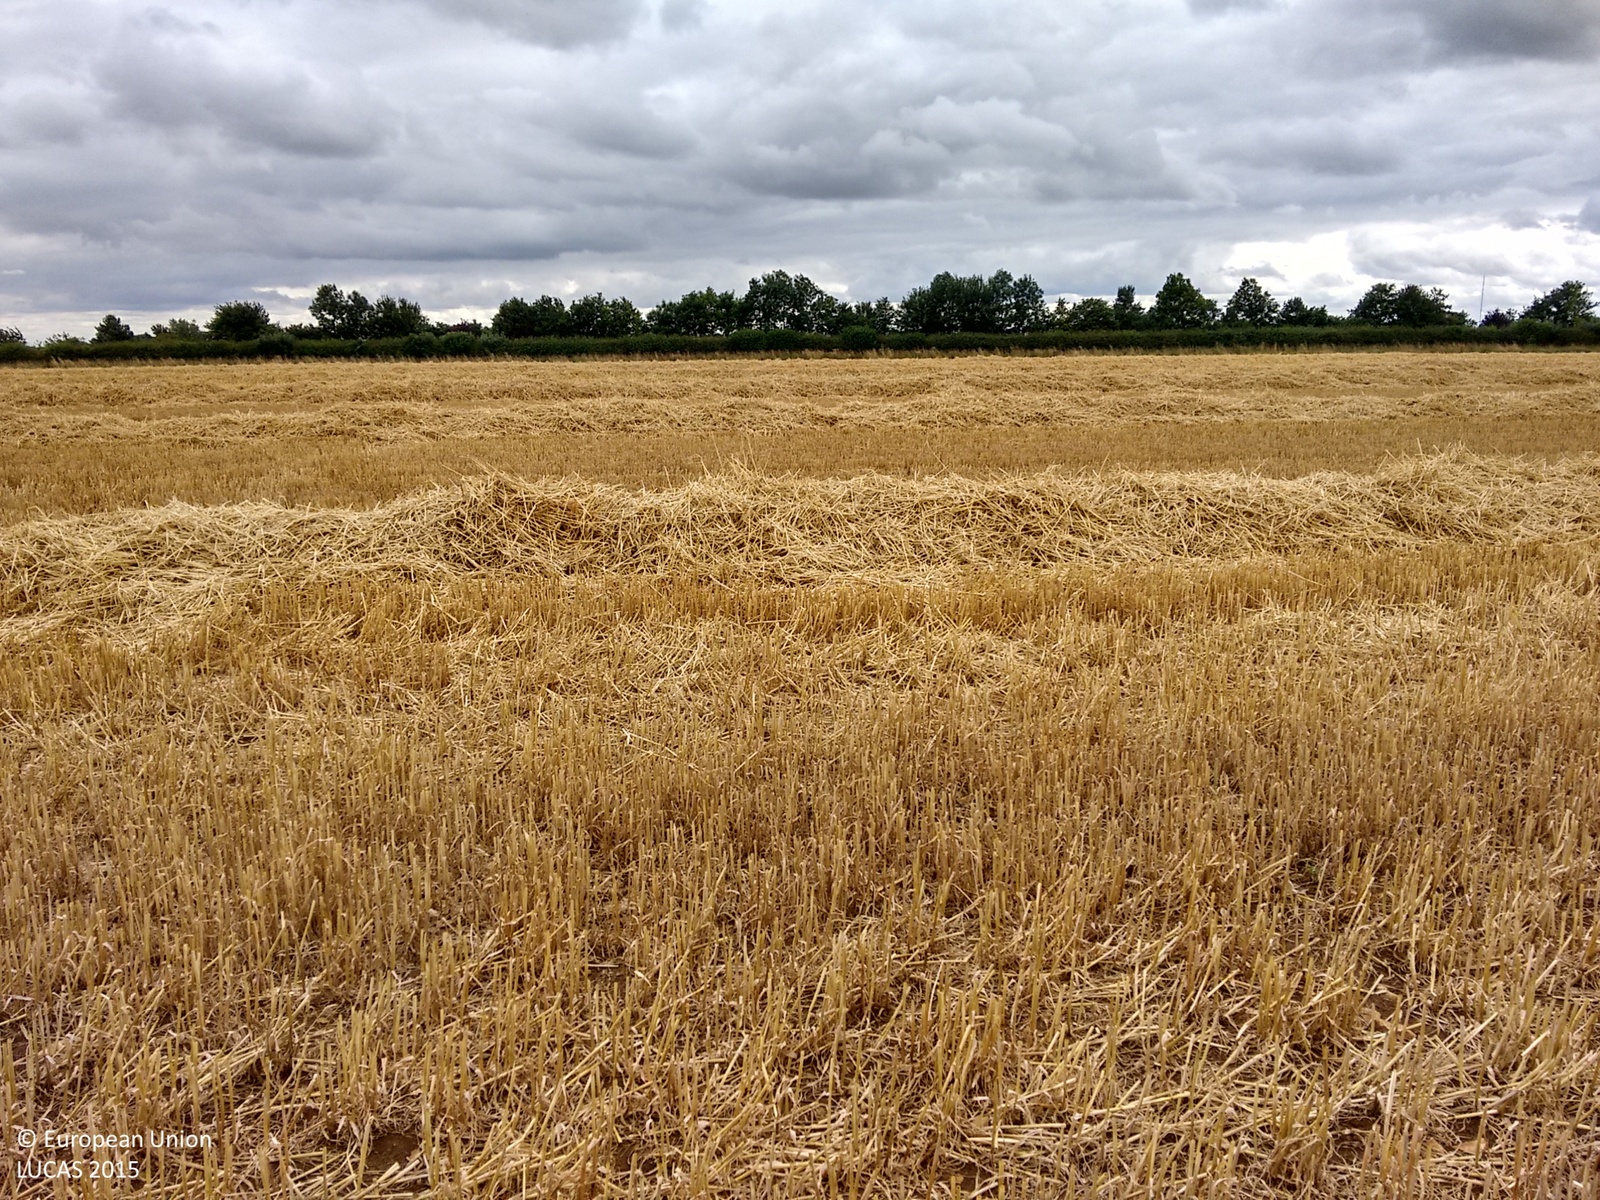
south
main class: Grassland
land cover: Grassland without tree/shrub cover
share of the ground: > 75 %
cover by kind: herbaceous plants 100 %
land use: Agriculture (excluding fallow land and kitchen gardens)
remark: Harvested field
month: July
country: GB
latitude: 52.8496
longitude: -0.7469
